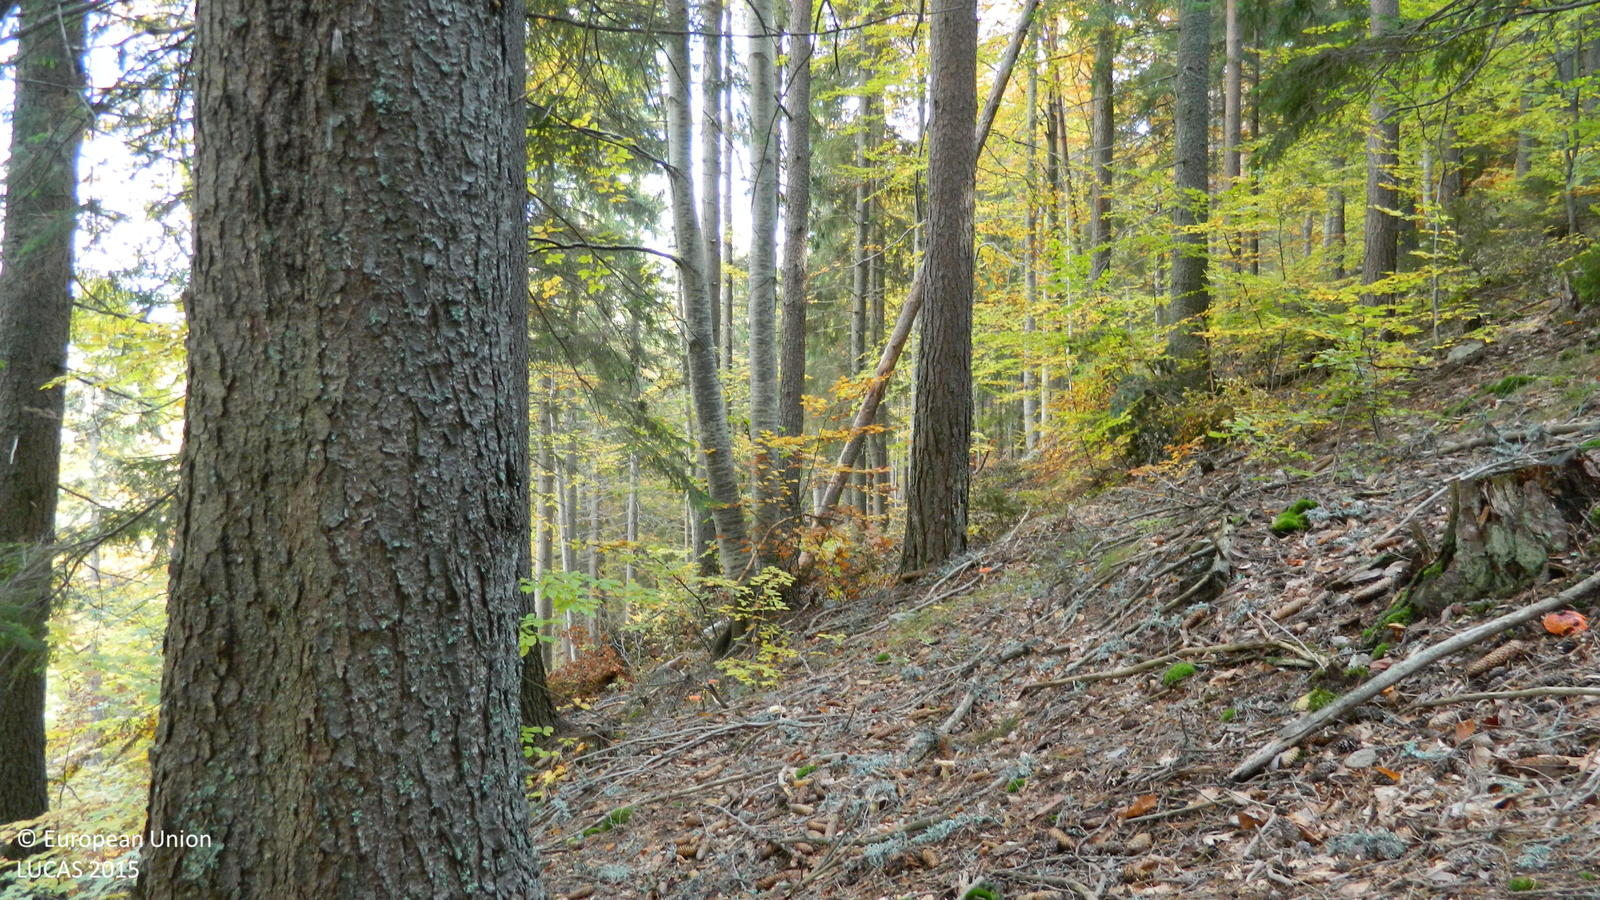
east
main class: Woodland
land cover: Spruce dominated mixed woodland
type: alpine coniferous forest
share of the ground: > 75 %
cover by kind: coniferous forest trees 75 %, broadleaved forest trees 25 %
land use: Forestry
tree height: > 5 m
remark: Clear cut
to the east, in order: Spruce dominated mixed woodland; Grassland with sparse tree/shrub cover; Other mixed woodland; Grassland without tree/shrub cover; Rivers and streams; Grassland without tree/shrub cover; Other mixed woodland
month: October
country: BG
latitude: 41.6934
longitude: 24.8874
